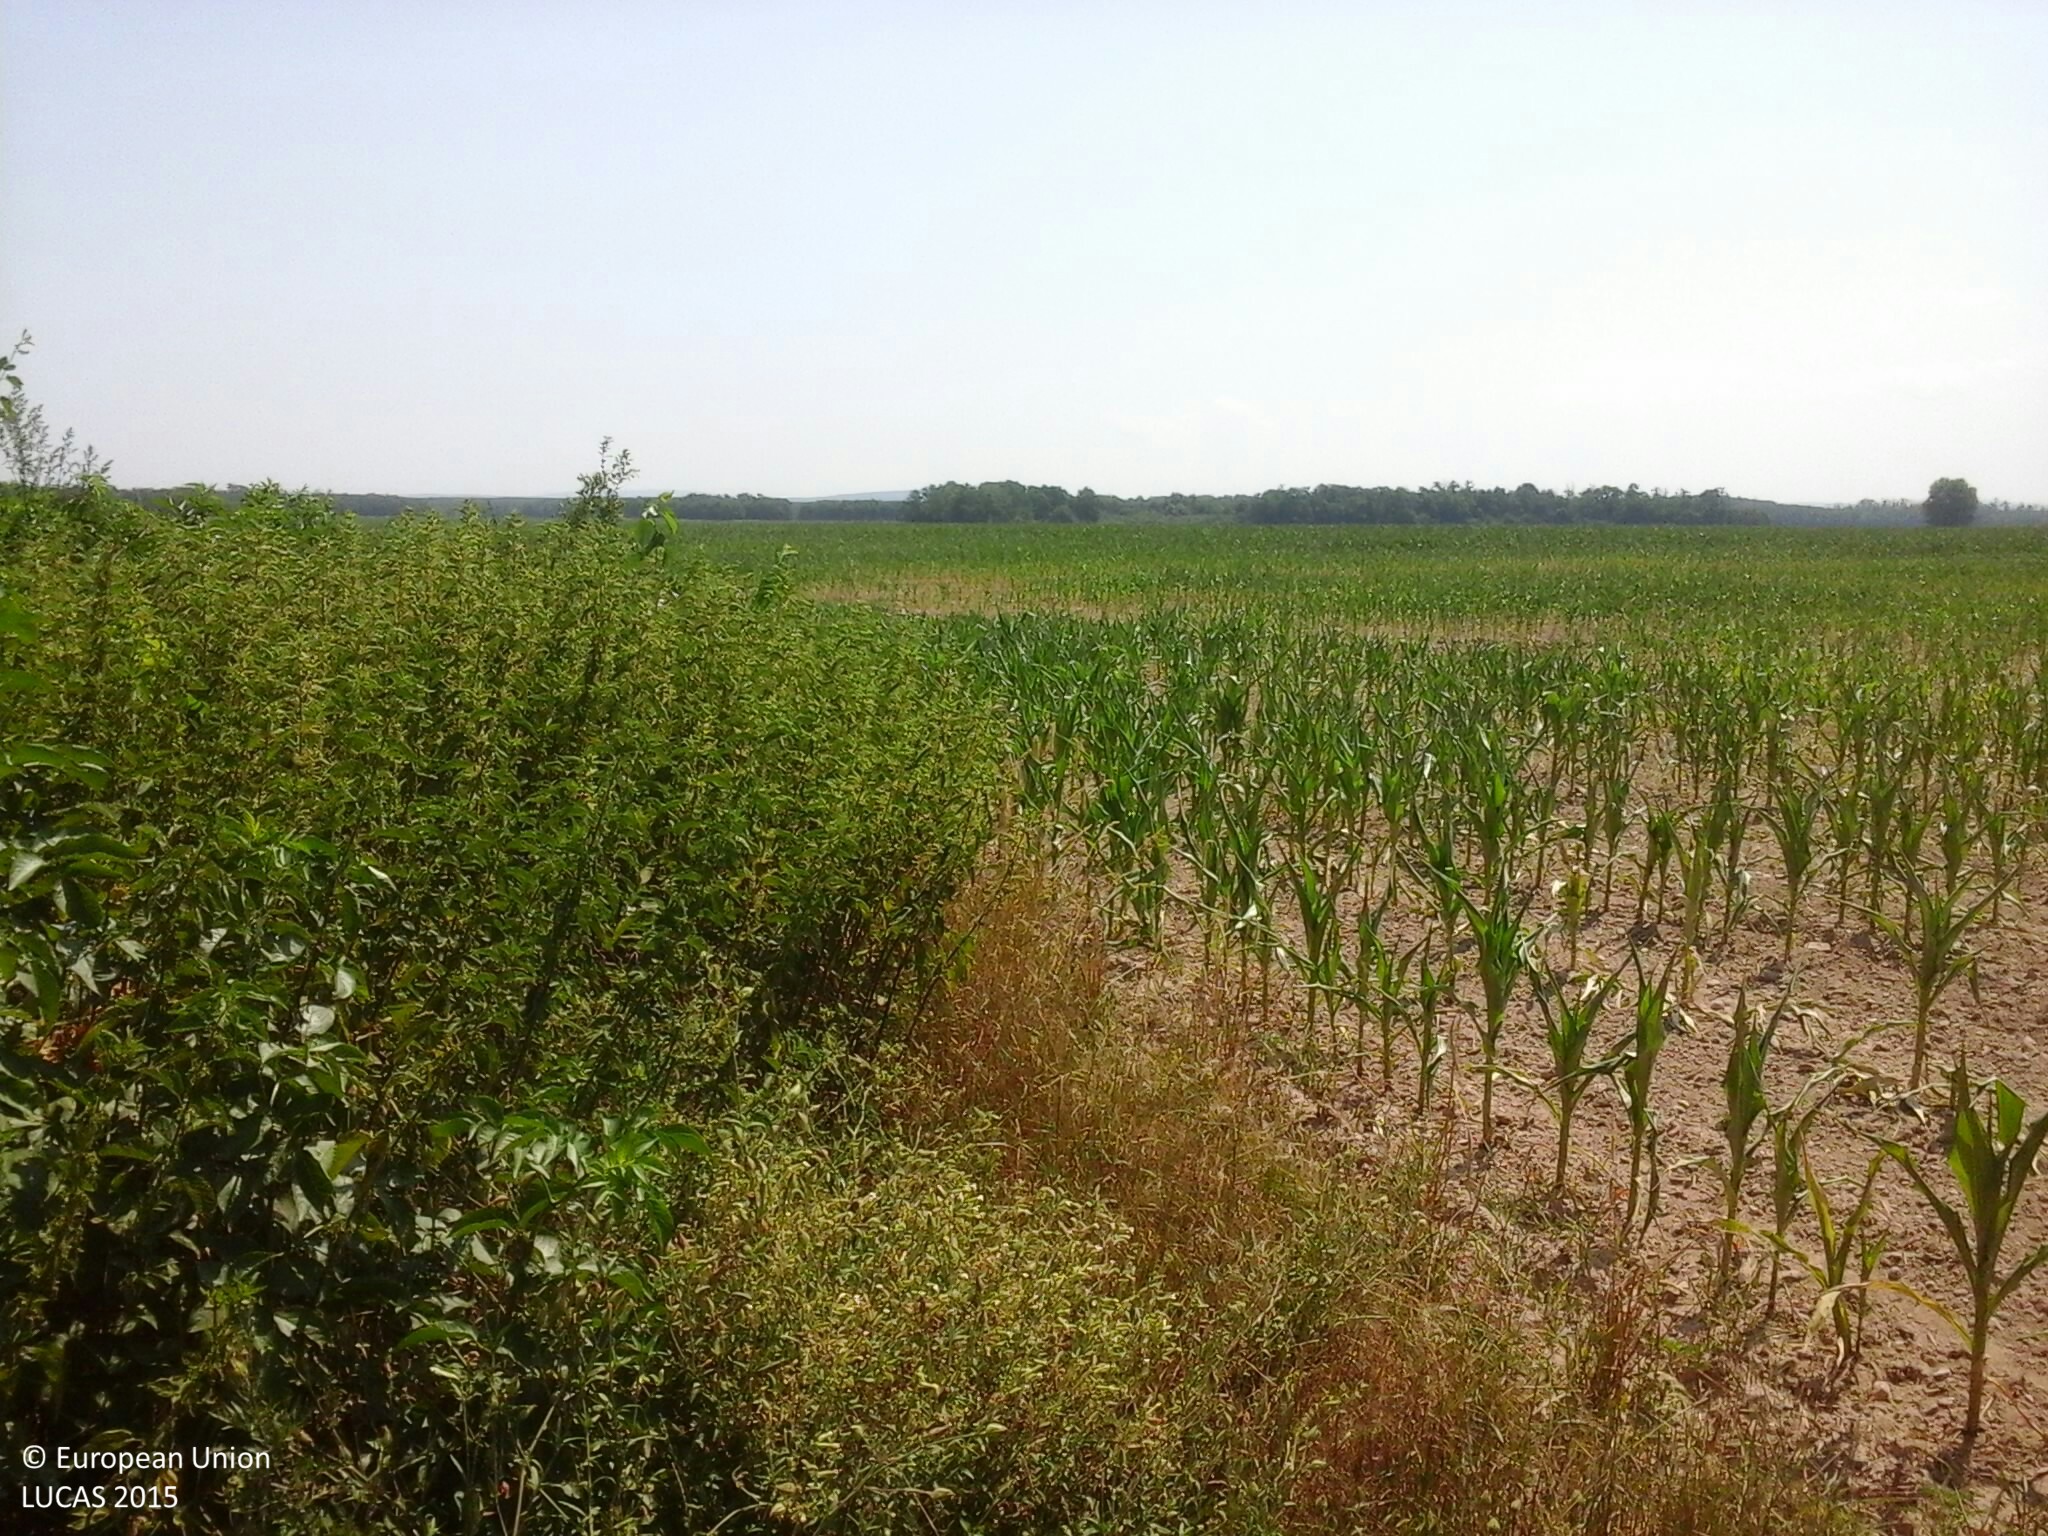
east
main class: Shrubland
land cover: Shrubland with sparse tree cover
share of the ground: 50 - 75 %
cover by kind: herbaceous plants 50 %, shrubs 45 %, broadleaved forest trees 5 %
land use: Semi-natural and natural areas not in use
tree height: < 5 m
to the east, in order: Shrubland with sparse tree cover; Maize
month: July
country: HU
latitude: 47.2004
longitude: 17.3591
